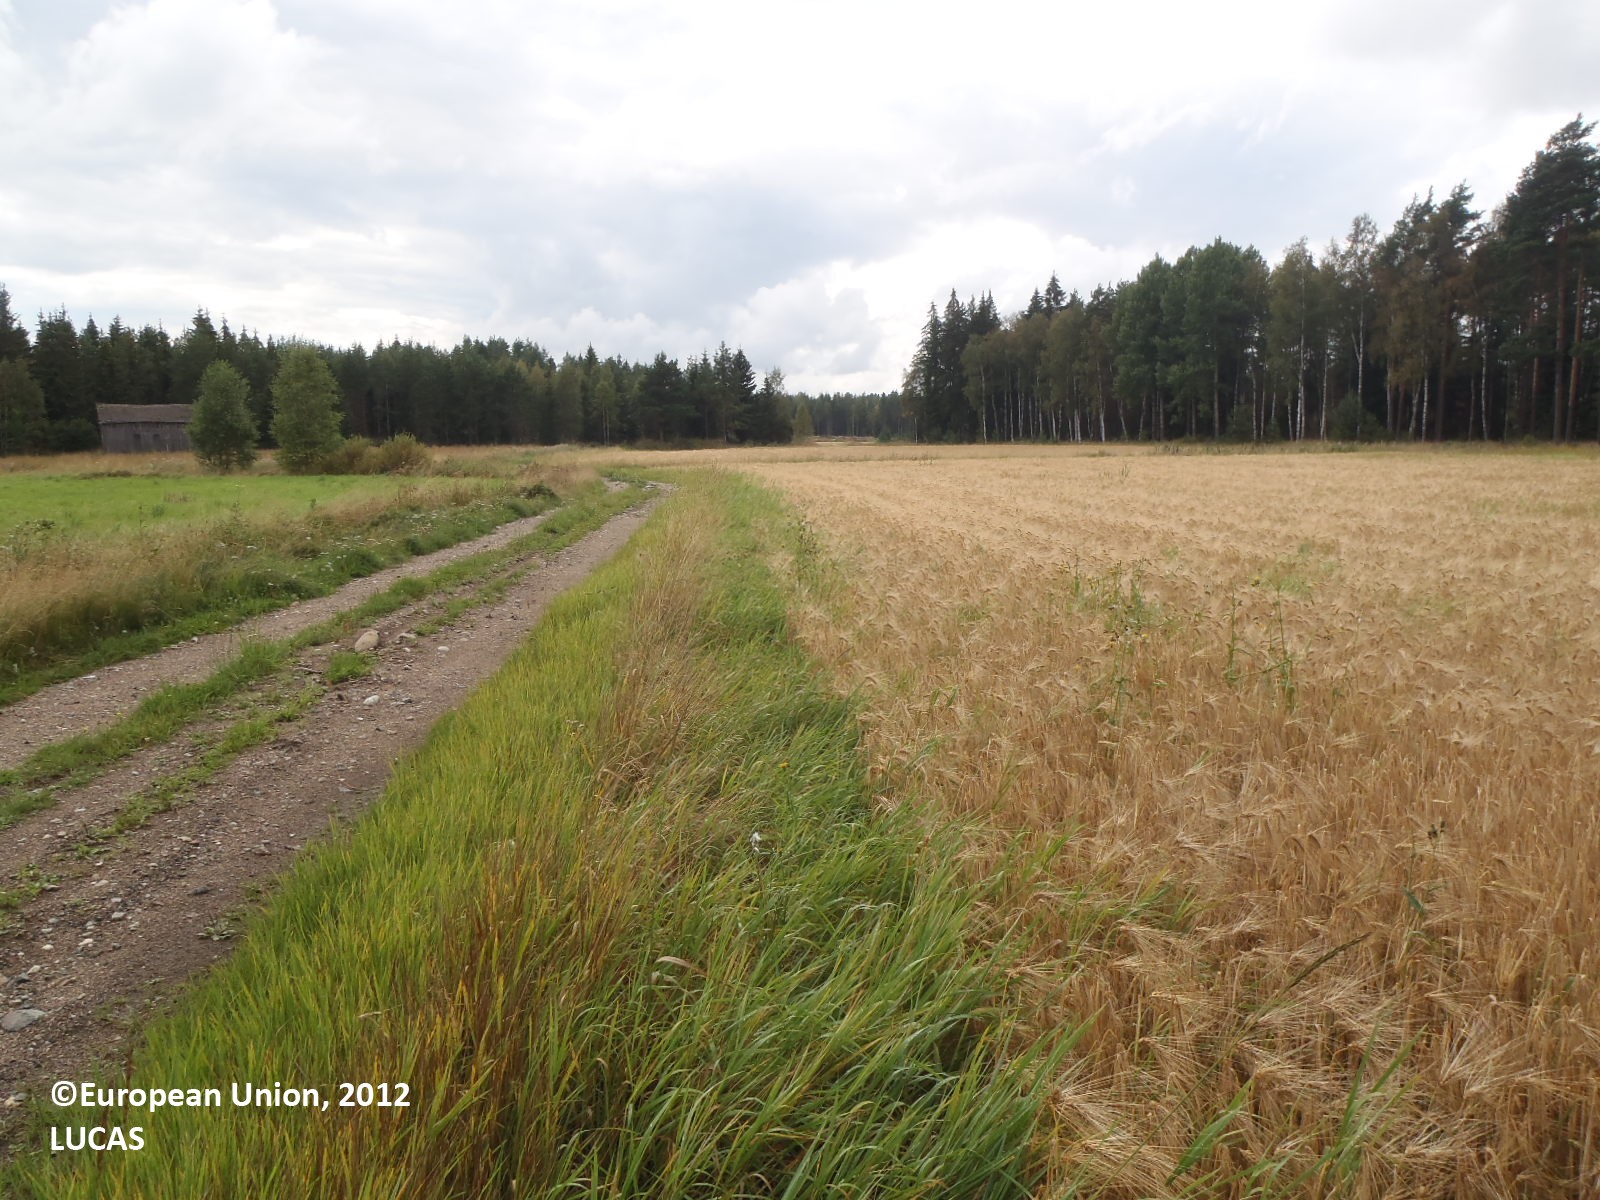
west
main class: Cropland
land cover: Barley
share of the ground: > 75 %
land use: Agriculture (excluding fallow land and kitchen gardens)
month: August
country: FI
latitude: 60.6178
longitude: 22.1791
